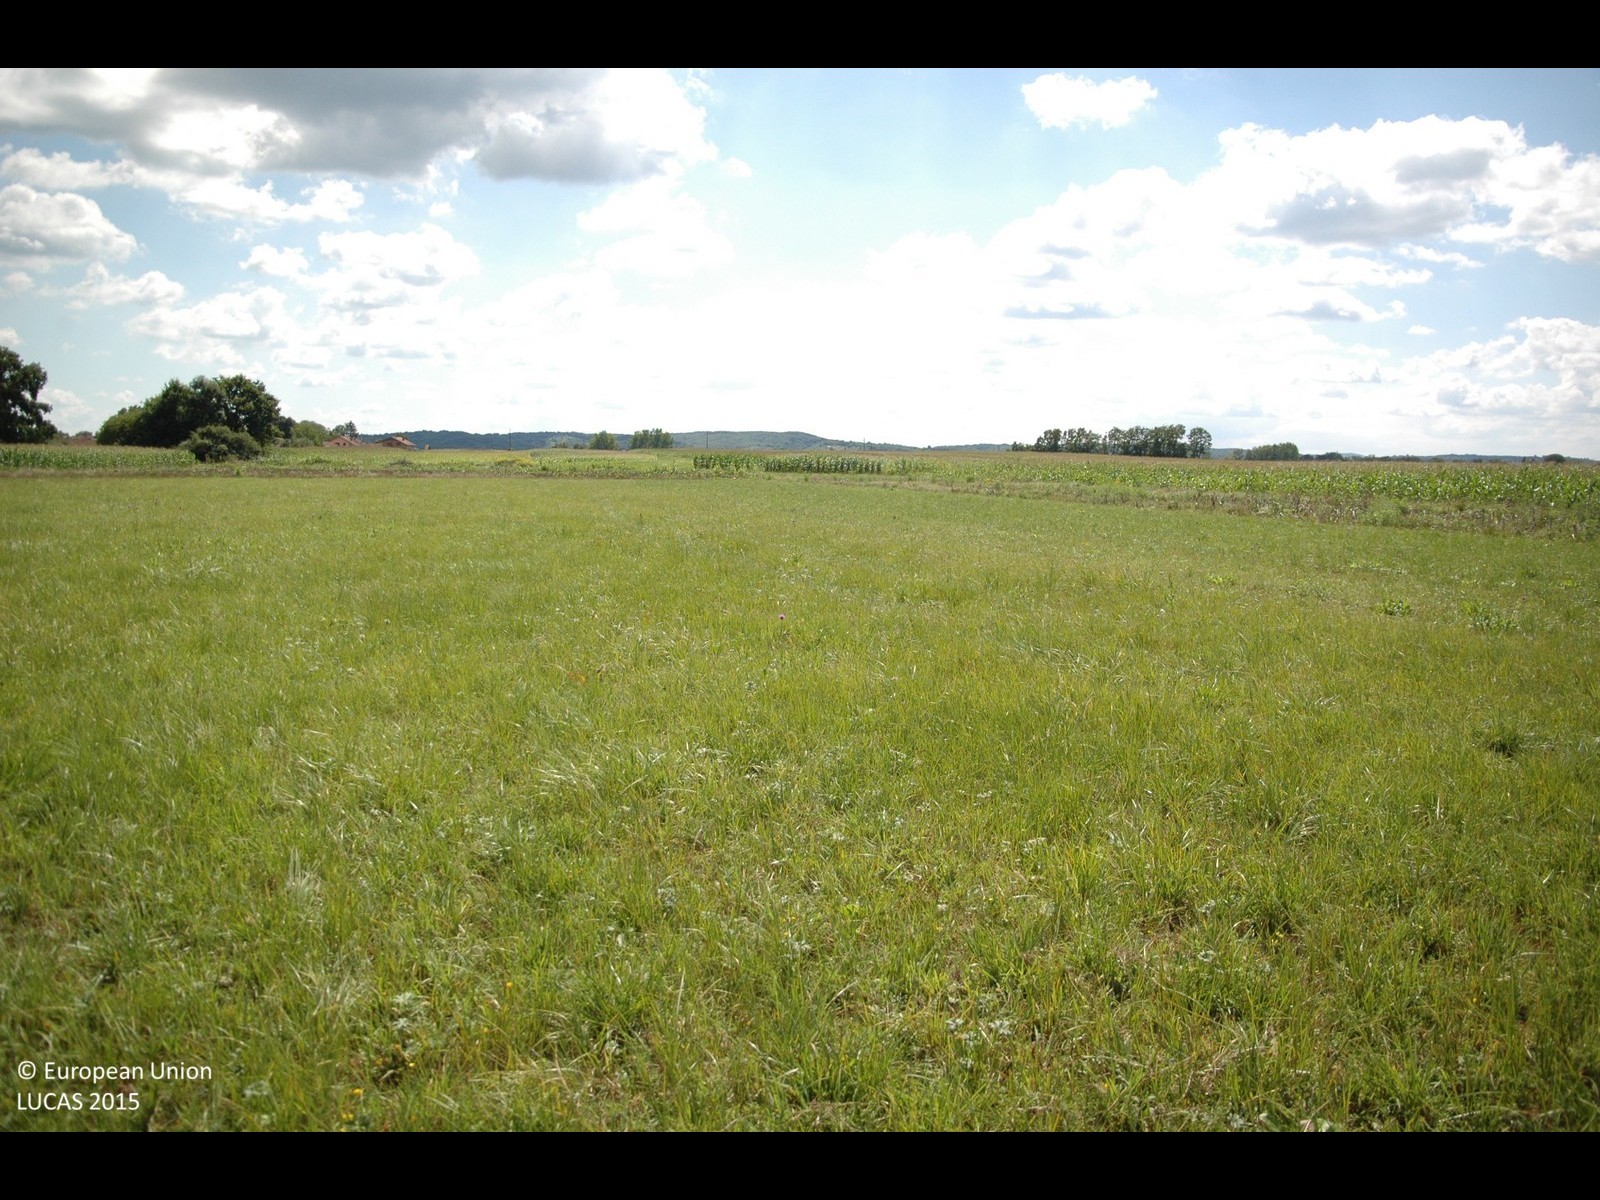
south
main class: Grassland
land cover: Grassland without tree/shrub cover
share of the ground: > 75 %
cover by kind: herbaceous plants 100 %
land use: Agriculture (excluding fallow land and kitchen gardens)
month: July
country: HR
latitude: 46.2490
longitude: 16.7069
